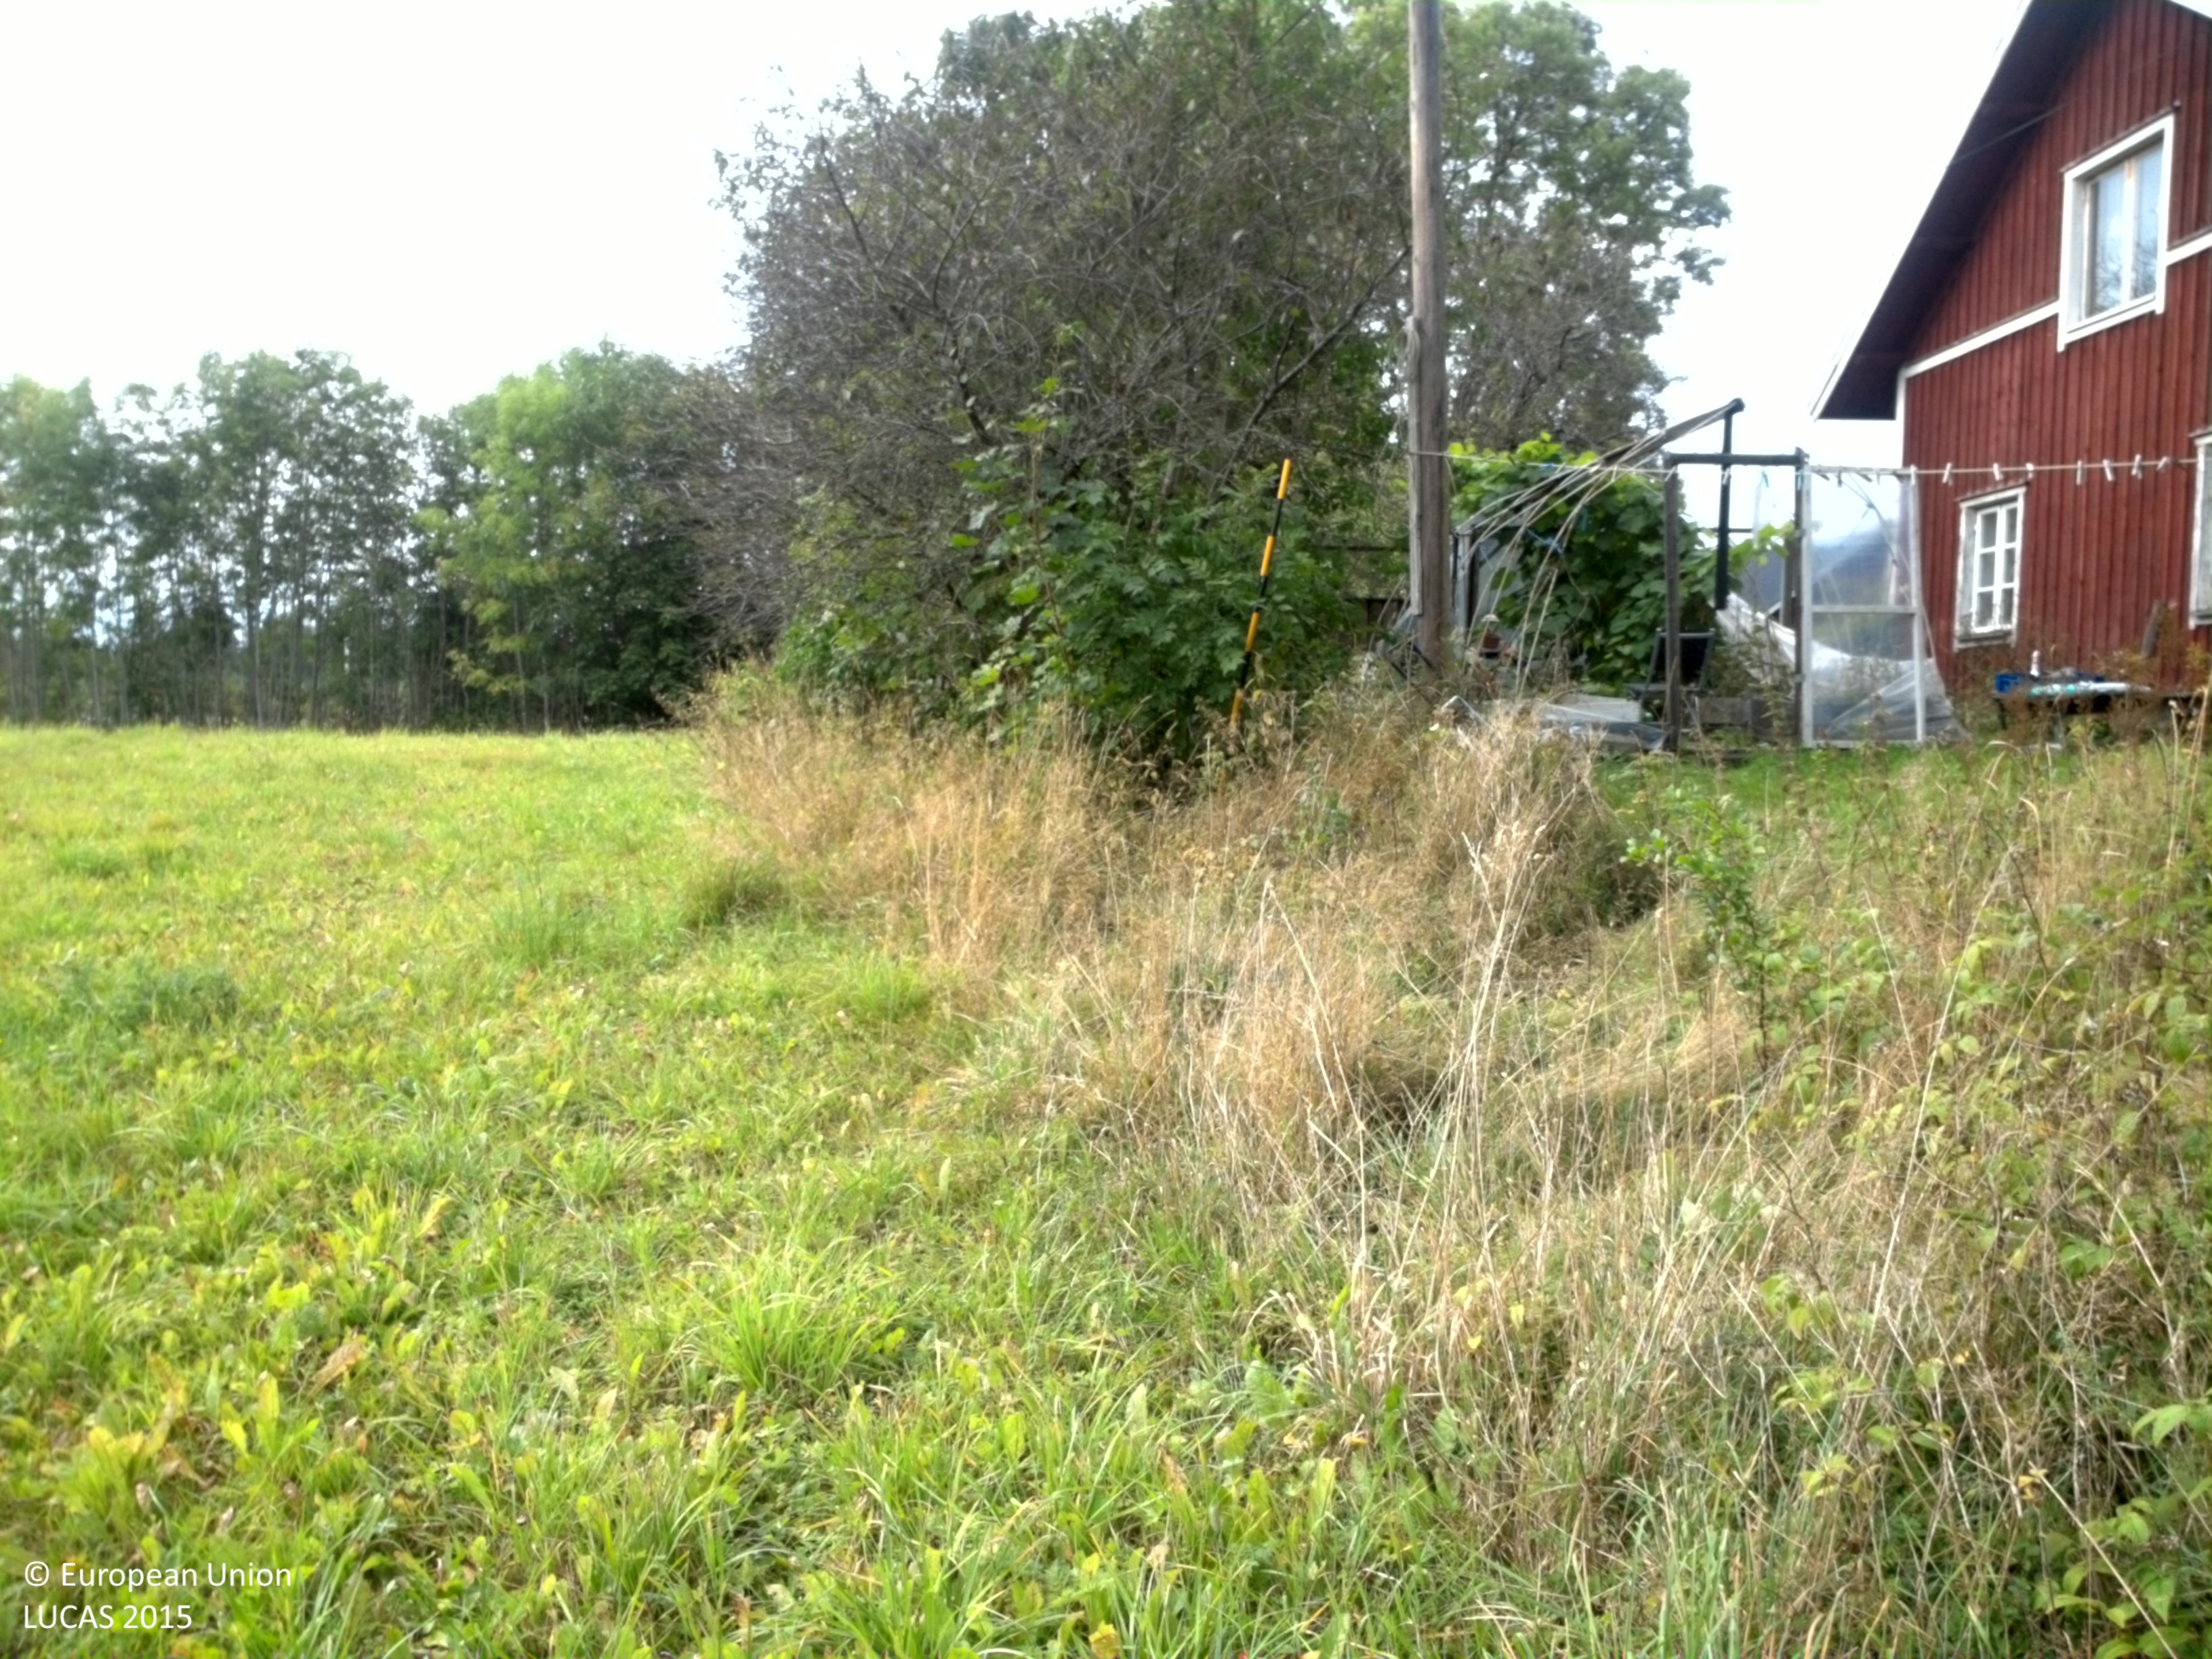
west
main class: Grassland
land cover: Grassland without tree/shrub cover
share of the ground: > 75 %
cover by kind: herbaceous plants 100 %
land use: Agriculture (excluding fallow land and kitchen gardens)
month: September
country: SE
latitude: 58.8700
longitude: 14.3455
